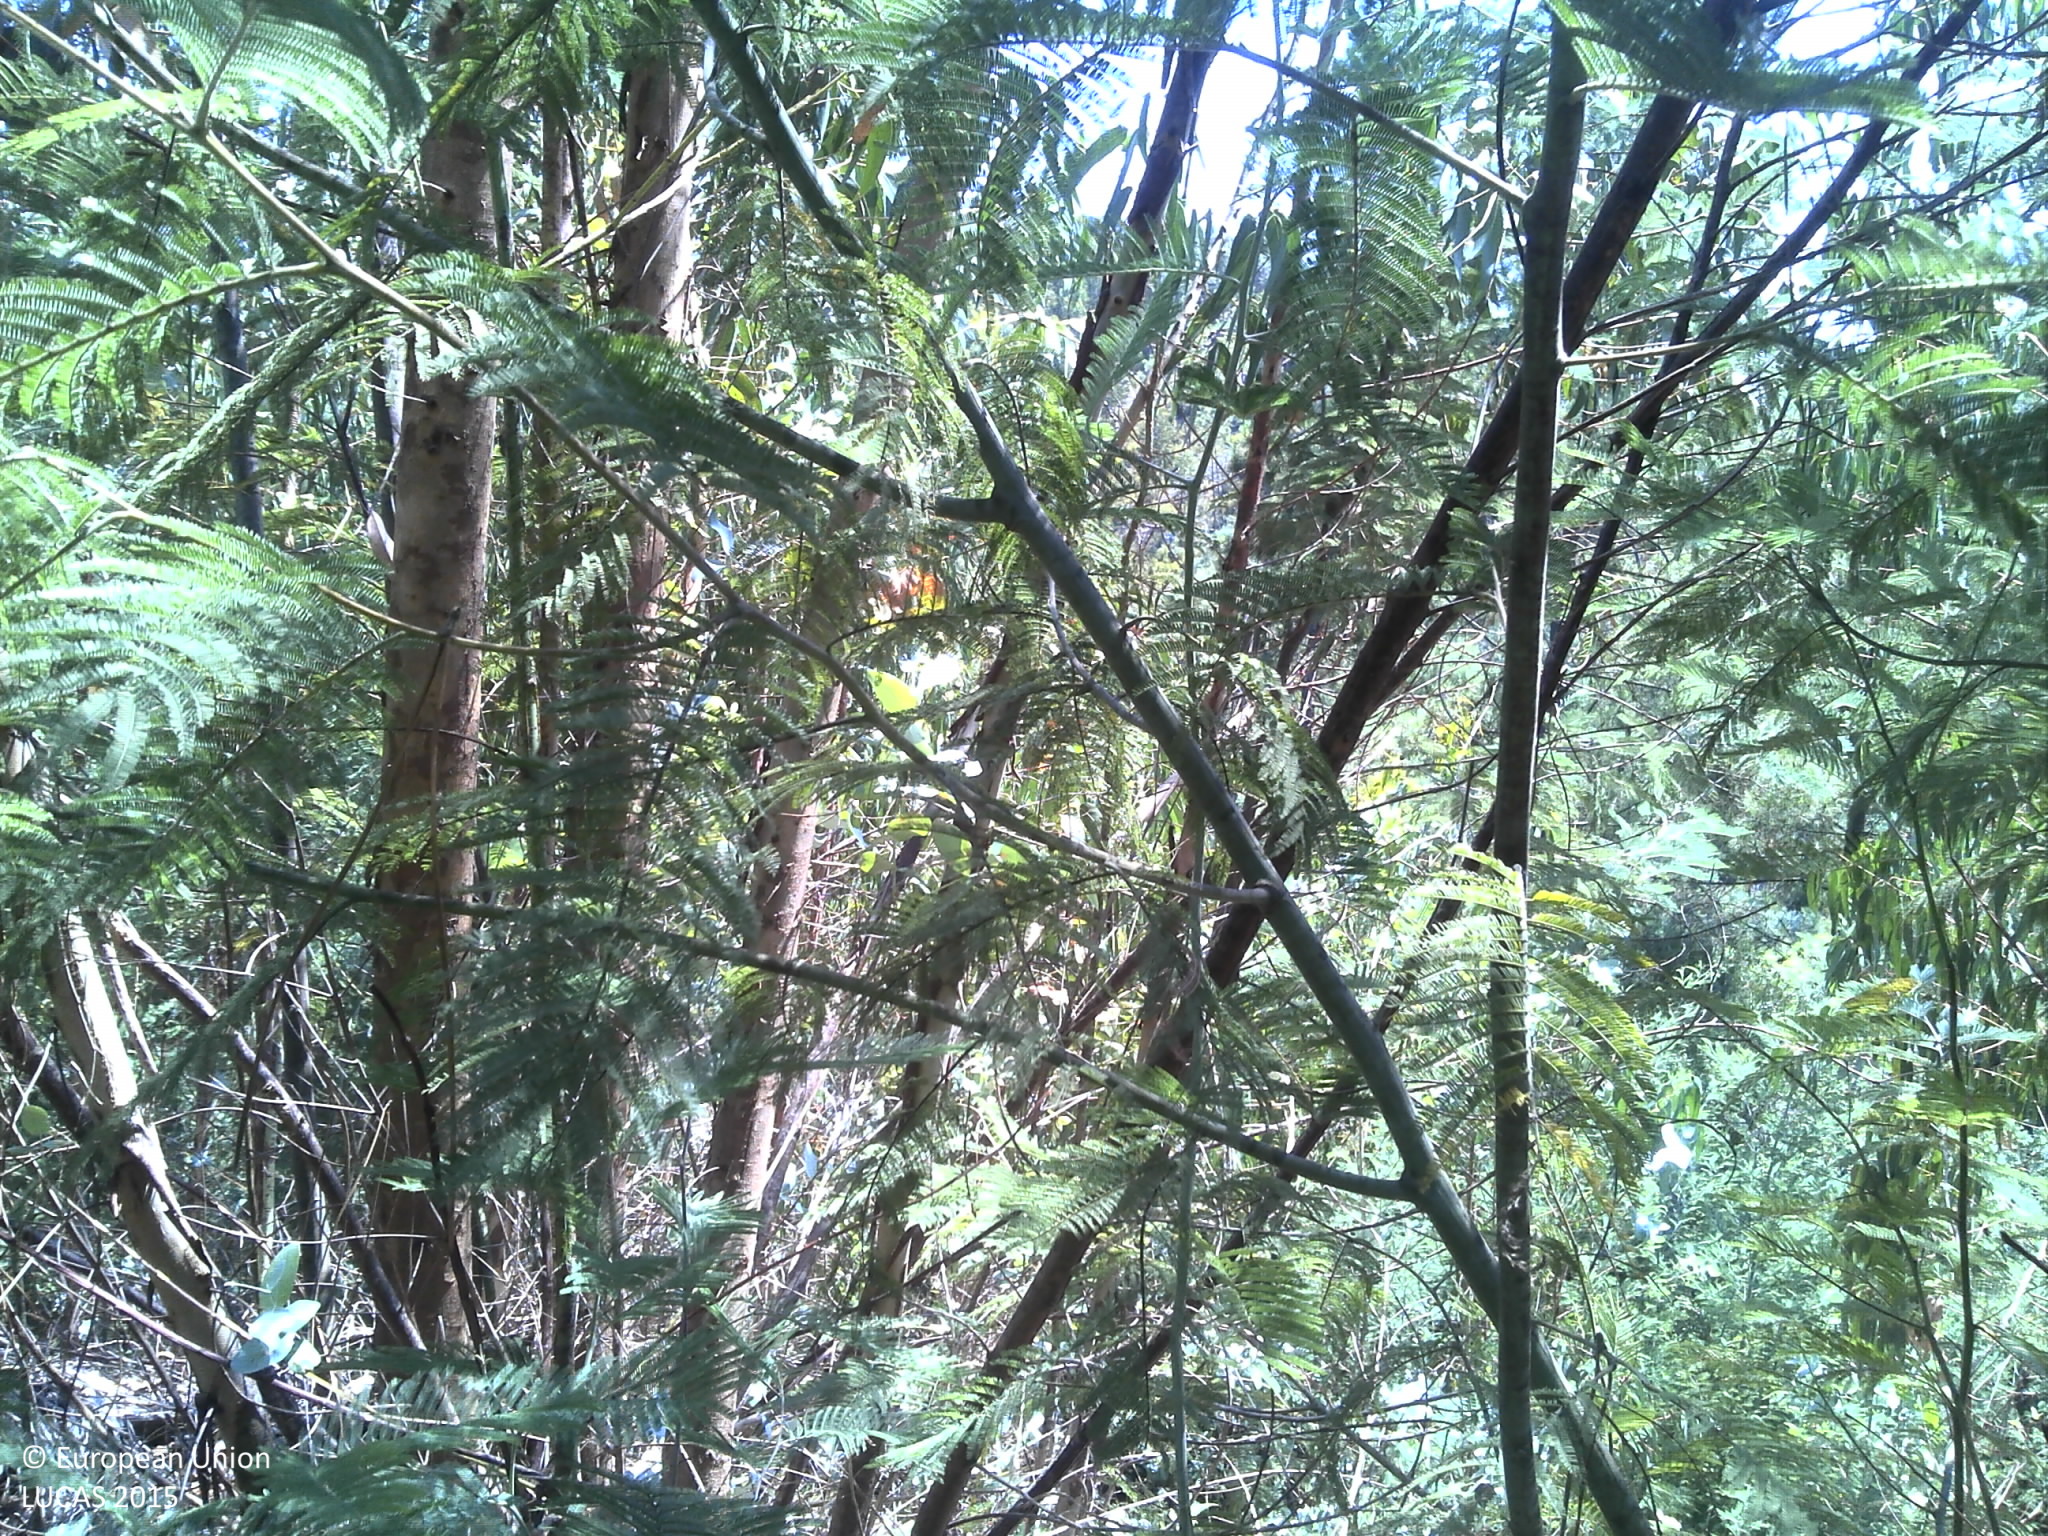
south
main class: Woodland
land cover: Broadleaved woodland
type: exotic forest
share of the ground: > 75 %
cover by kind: broadleaved forest trees 70 %, shrubs 20 %, unconsolidated bare surface 10 %
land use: Forestry
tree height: > 5 m
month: July
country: PT
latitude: 40.6970
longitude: -8.3747
